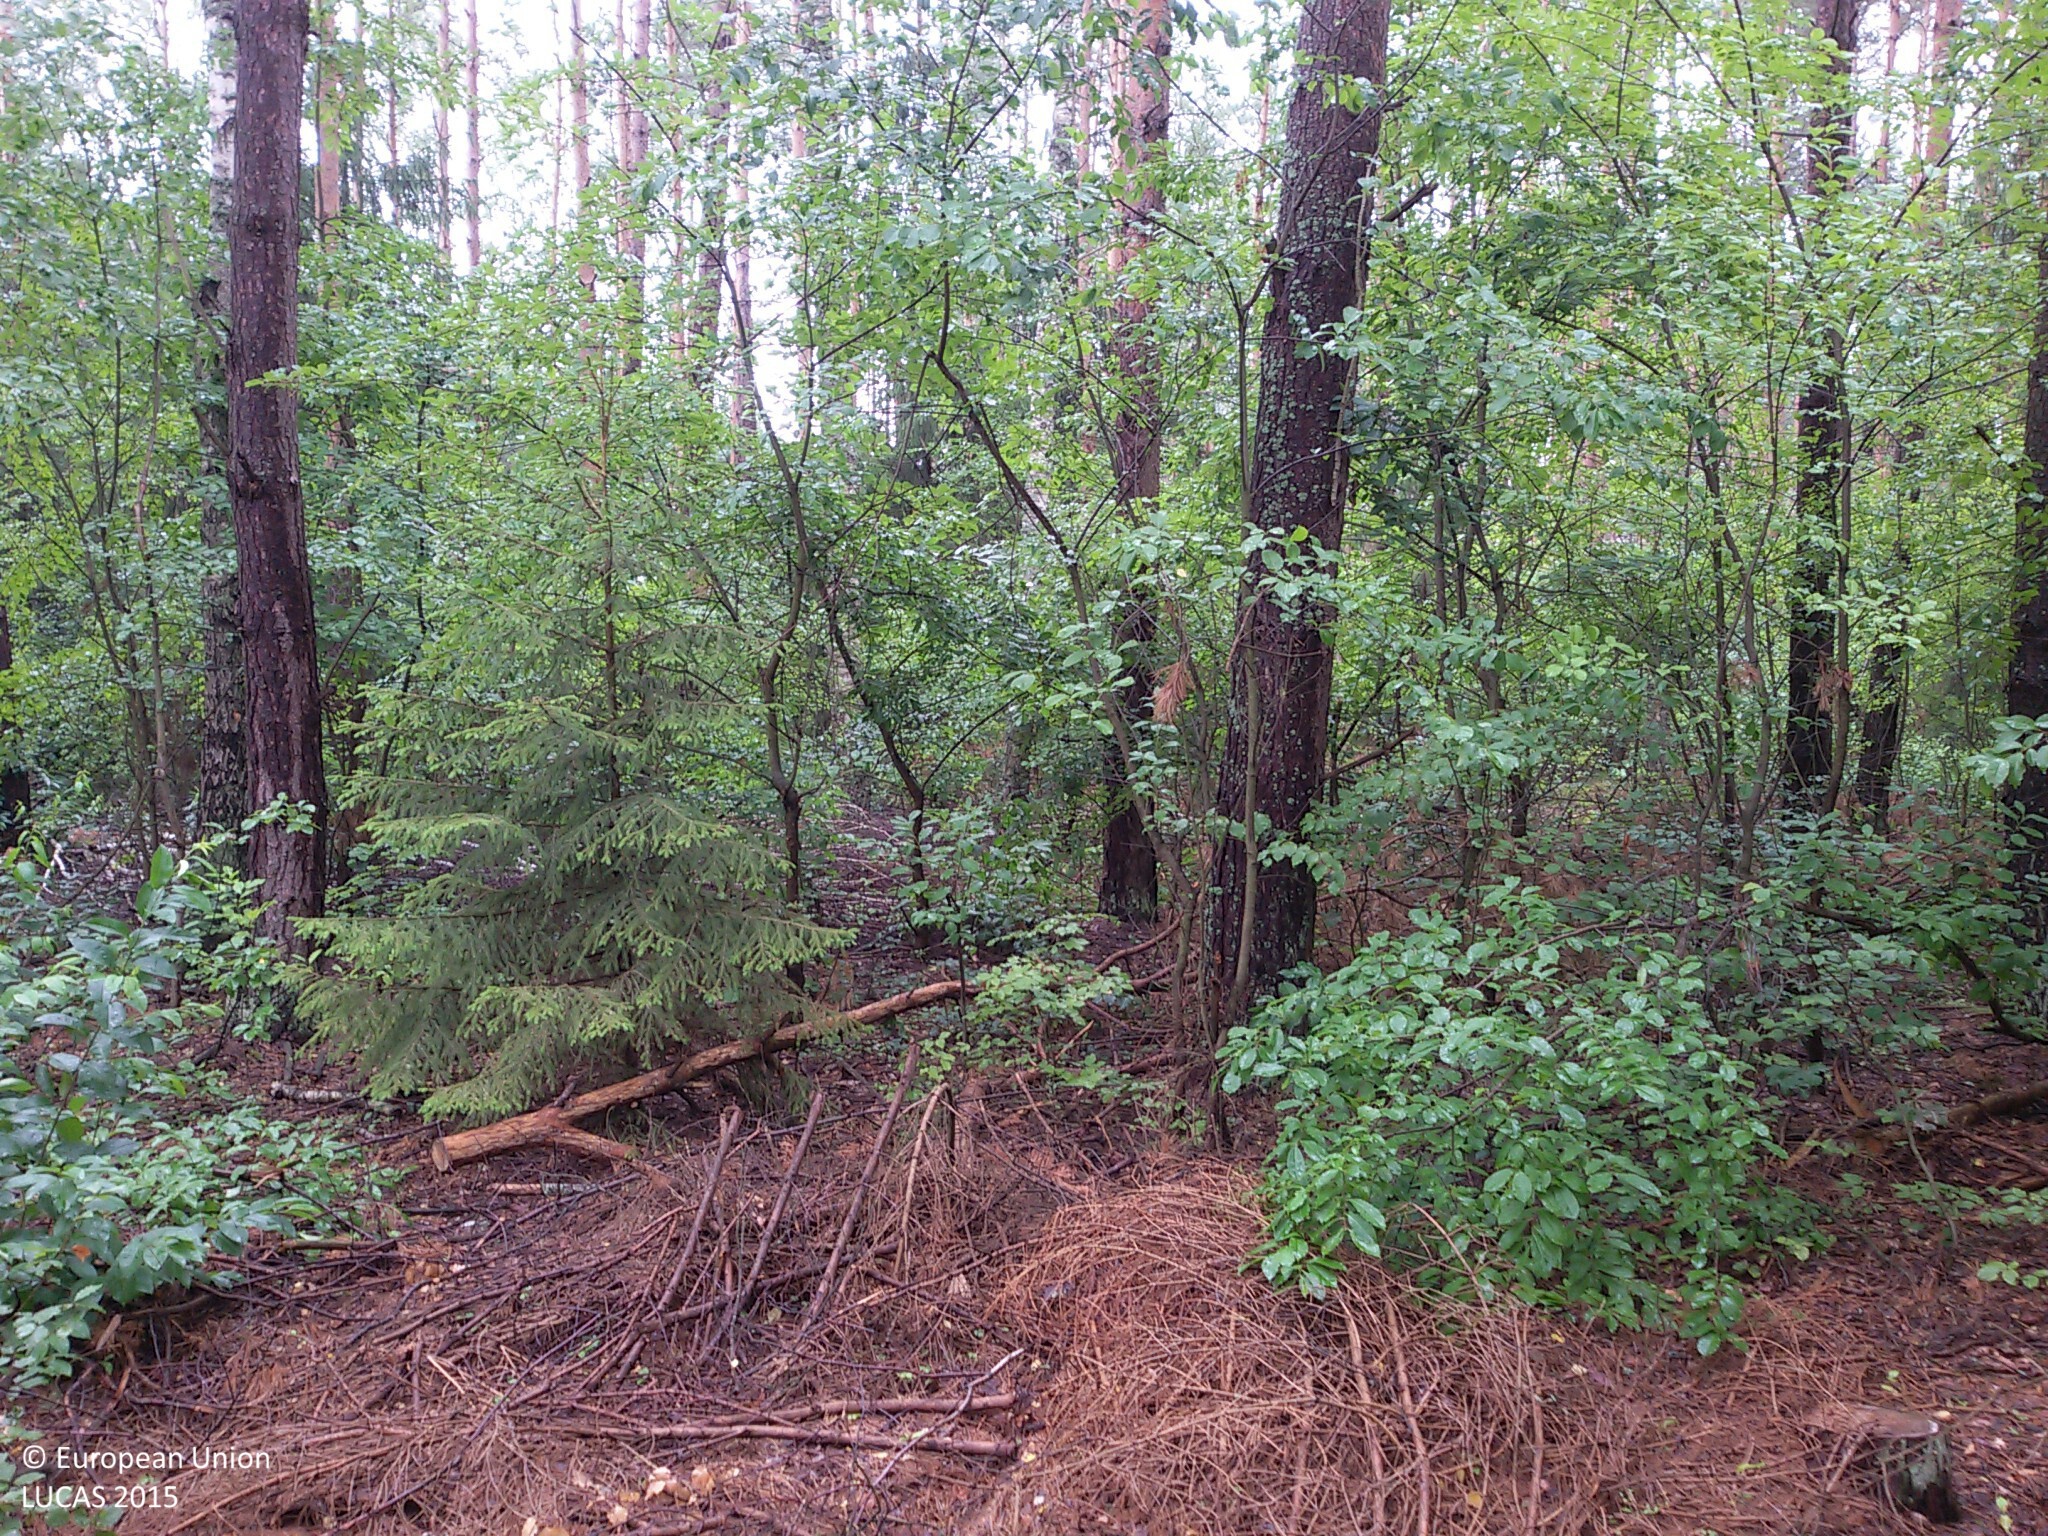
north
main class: Woodland
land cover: Pine dominated mixed woodland
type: hemiboreal forest and nemoral coniferous forest and mixed broadleaved-coniferous forest
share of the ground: > 75 %
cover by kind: coniferous forest trees 50 %, broadleaved forest trees 25 %, shrubs 10 %, herbaceous plants 10 %, lichens and mosses 5 %
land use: Forestry
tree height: > 5 m
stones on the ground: < 10 %
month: July
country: PL
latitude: 53.3533
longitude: 20.9957
